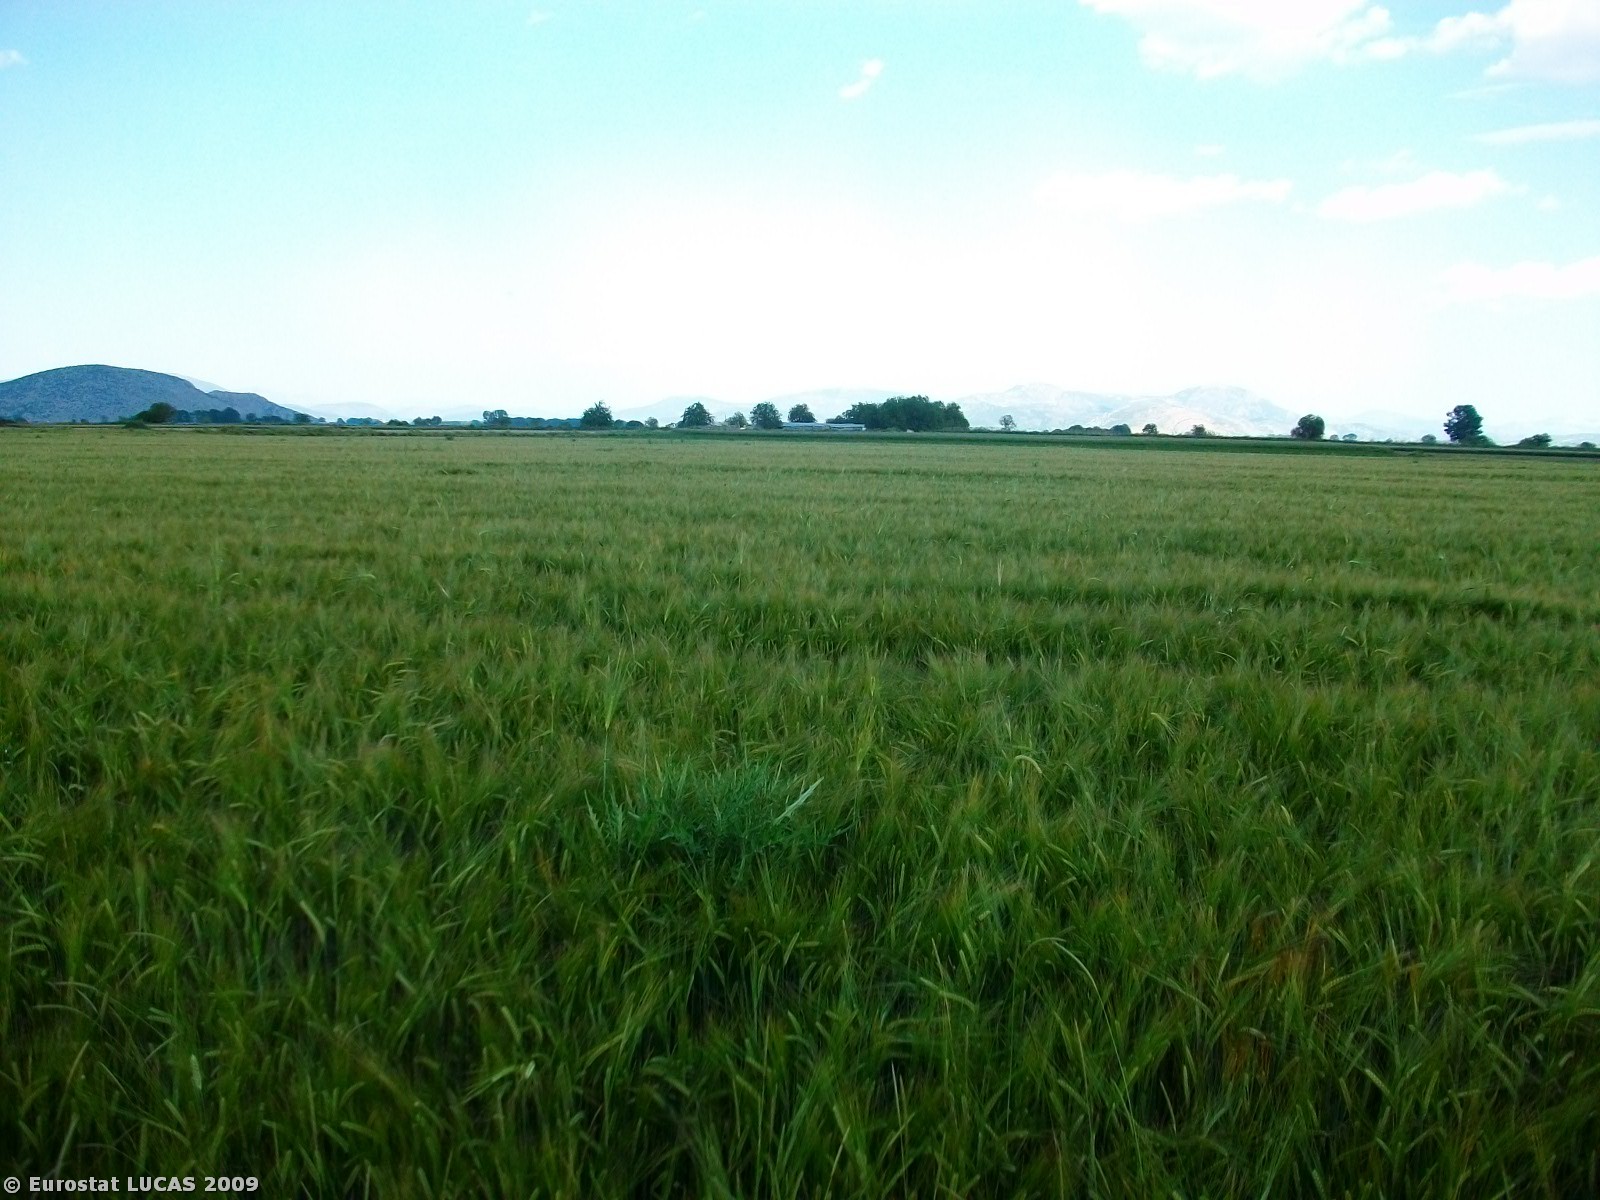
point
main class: Cropland
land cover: Durum wheat
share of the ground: > 75 %
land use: Agriculture (excluding fallow land and kitchen gardens)
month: May
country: GR
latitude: 38.4537
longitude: 23.0783
